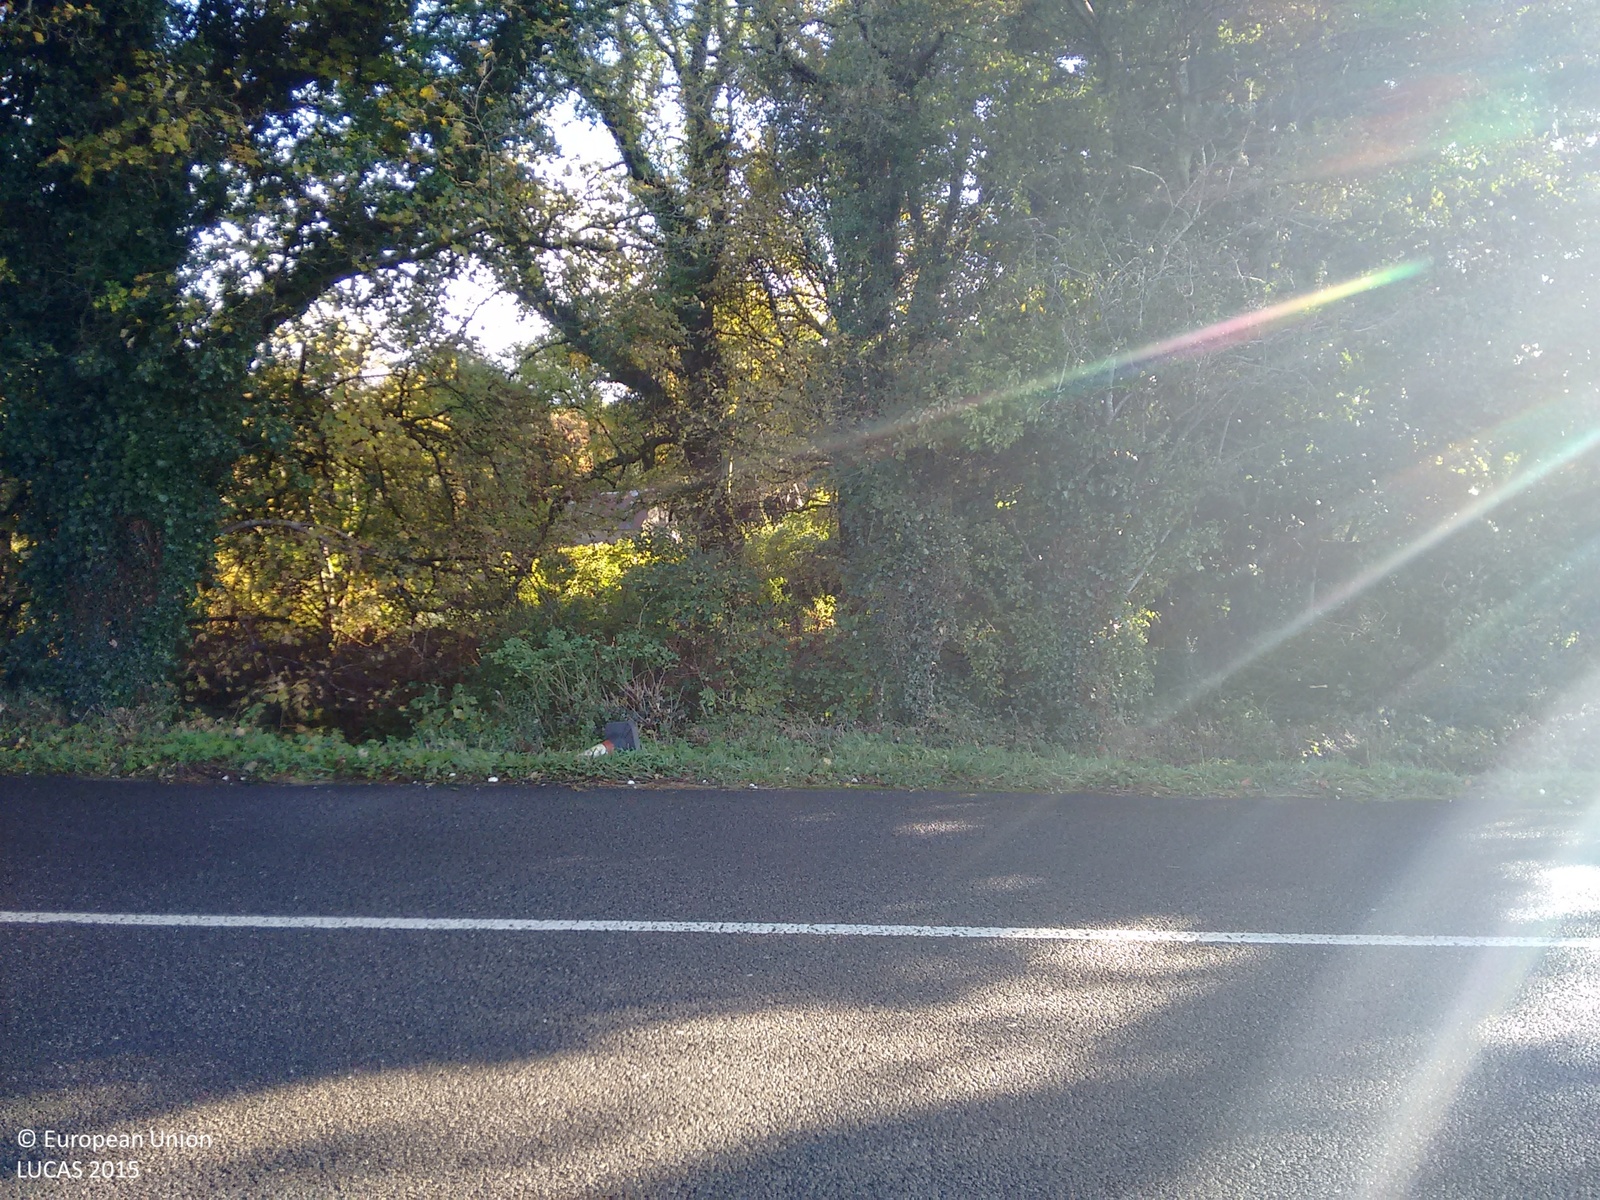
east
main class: Woodland
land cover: Broadleaved woodland
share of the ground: > 75 %
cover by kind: broadleaved forest trees 70 %, shrubs 20 %, herbaceous plants 10 %
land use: Residential
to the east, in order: Broadleaved woodland; Grassland without tree/shrub cover; Electric lines; Grassland without tree/shrub cover; Fences; Abandoned hedges; Shruby margins; Grass margins; Paved roads, cycling and walking lanes; Grass margins; Broadleaved woodland; Electric lines; Broadleaved woodland; Tracks; Broadleaved woodland; Fences; Grassland without tree/shrub cover; Abandoned hedges; Grassland without tree/shrub cover; Other mixed woodland
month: October
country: IE
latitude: 54.0917
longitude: -8.0806
